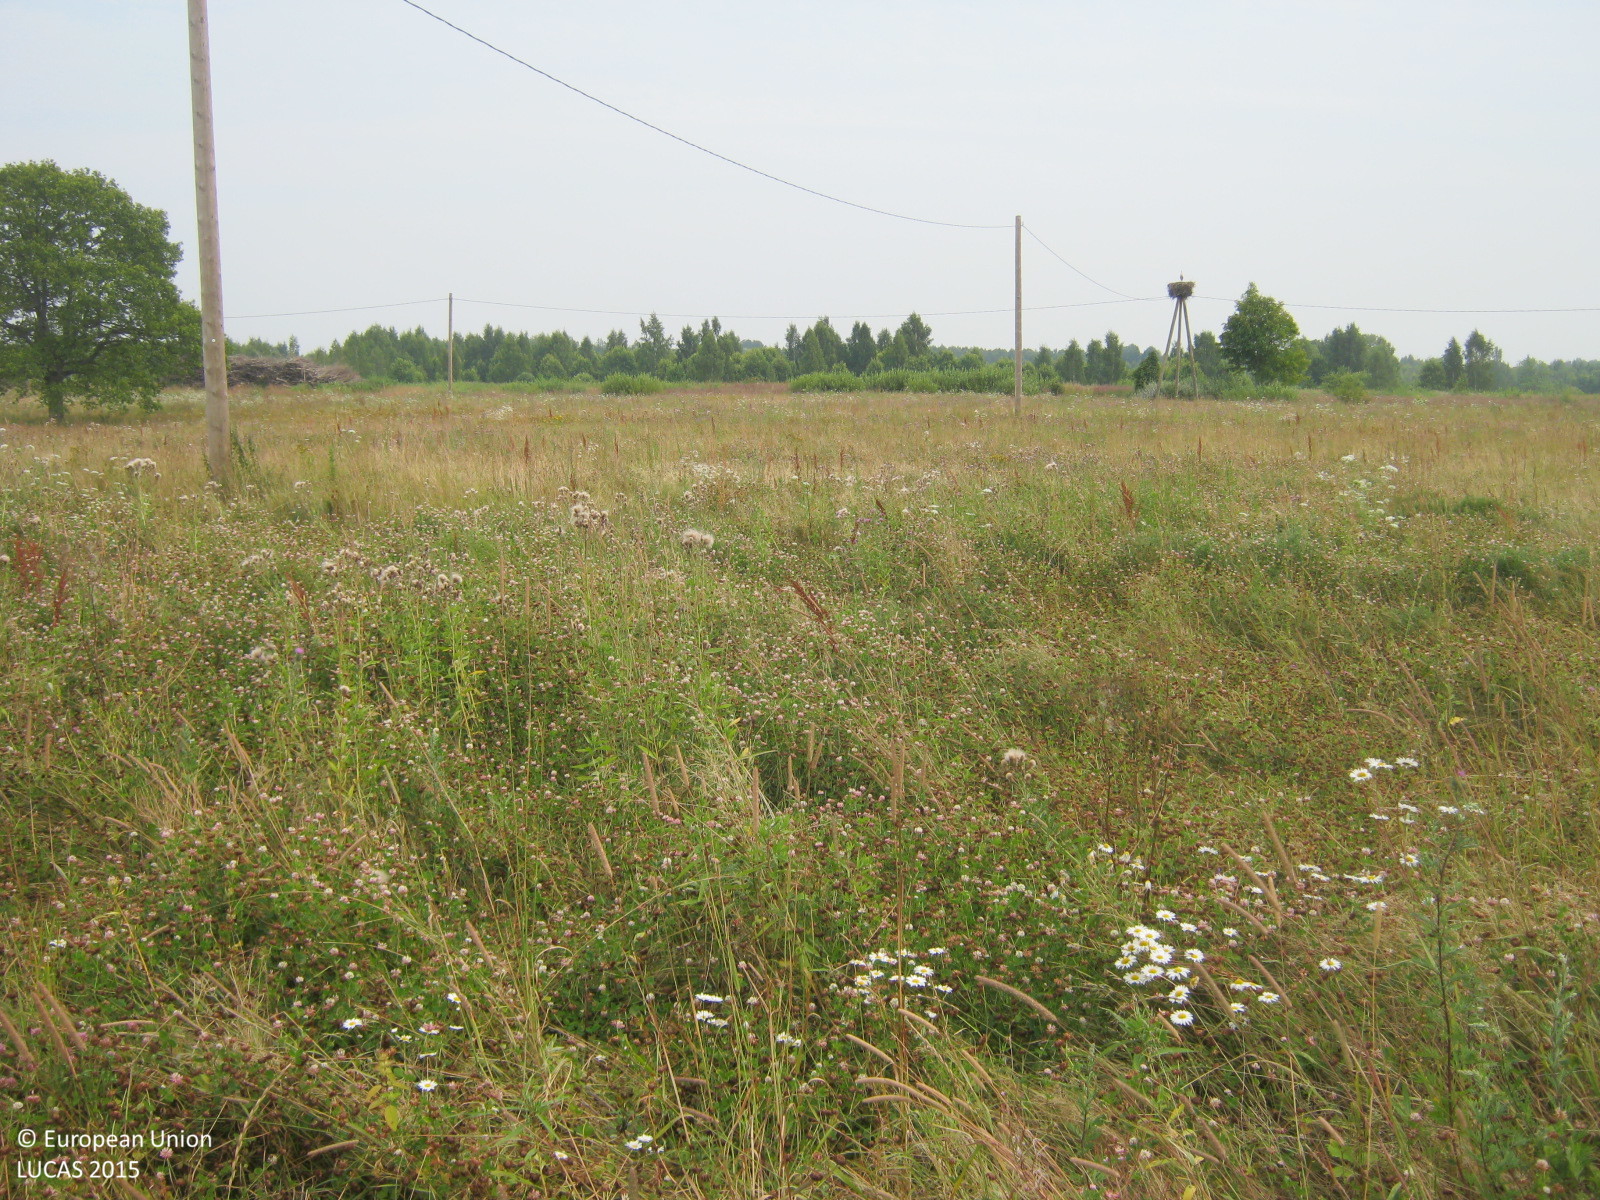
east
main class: Grassland
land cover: Spontaneously vegetated surfaces
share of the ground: > 75 %
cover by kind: herbaceous plants 100 %
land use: Fallow land
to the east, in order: Spontaneously vegetated surfaces; Electric lines; Spontaneously vegetated surfaces; Electric lines; Single bushes/trees; Spontaneously vegetated surfaces; Grass margins; Paved roads, cycling and walking lanes; Shrubland without tree cover; Spontaneously vegetated surfaces; Shrubland without tree cover
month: August
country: LV
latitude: 57.4135
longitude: 24.4576
